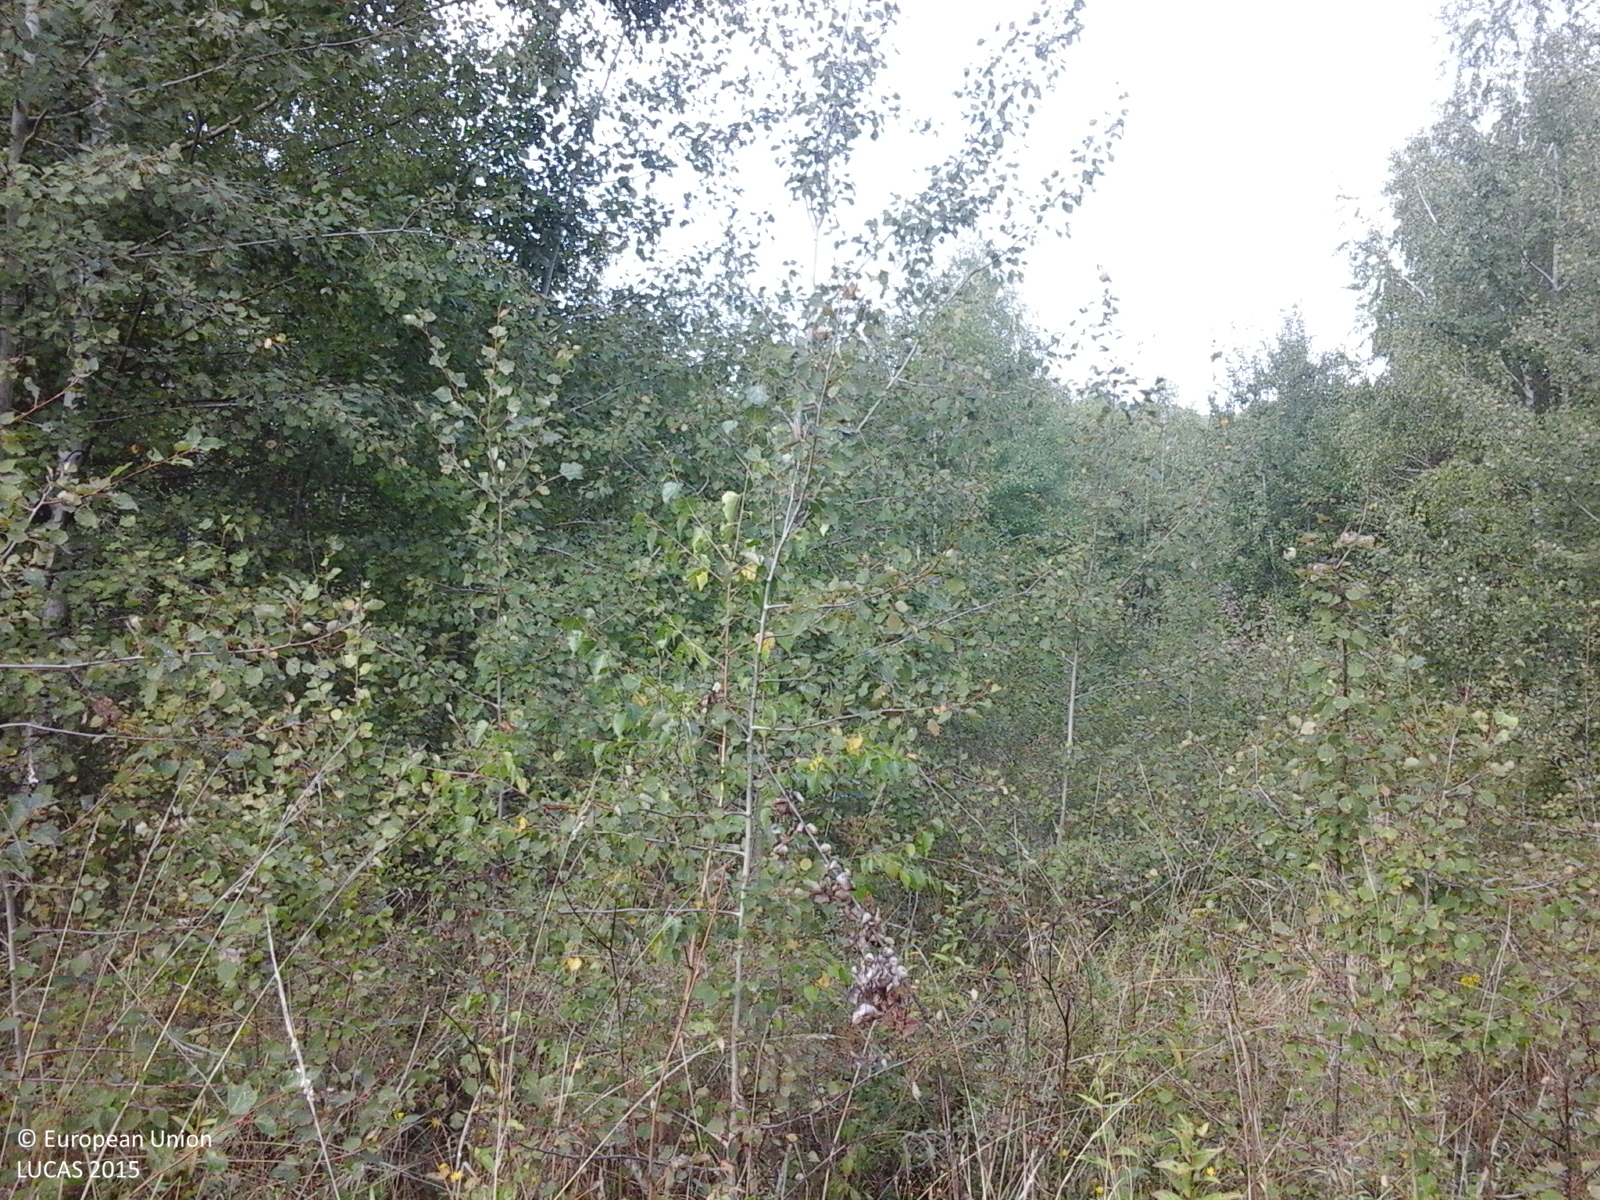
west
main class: Woodland
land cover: Broadleaved woodland
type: non-riverine alder, birch or aspen forest
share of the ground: > 75 %
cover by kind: broadleaved forest trees 100 %
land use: Forestry
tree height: > 5 m
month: September
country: RO
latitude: 45.4671
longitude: 22.0489
